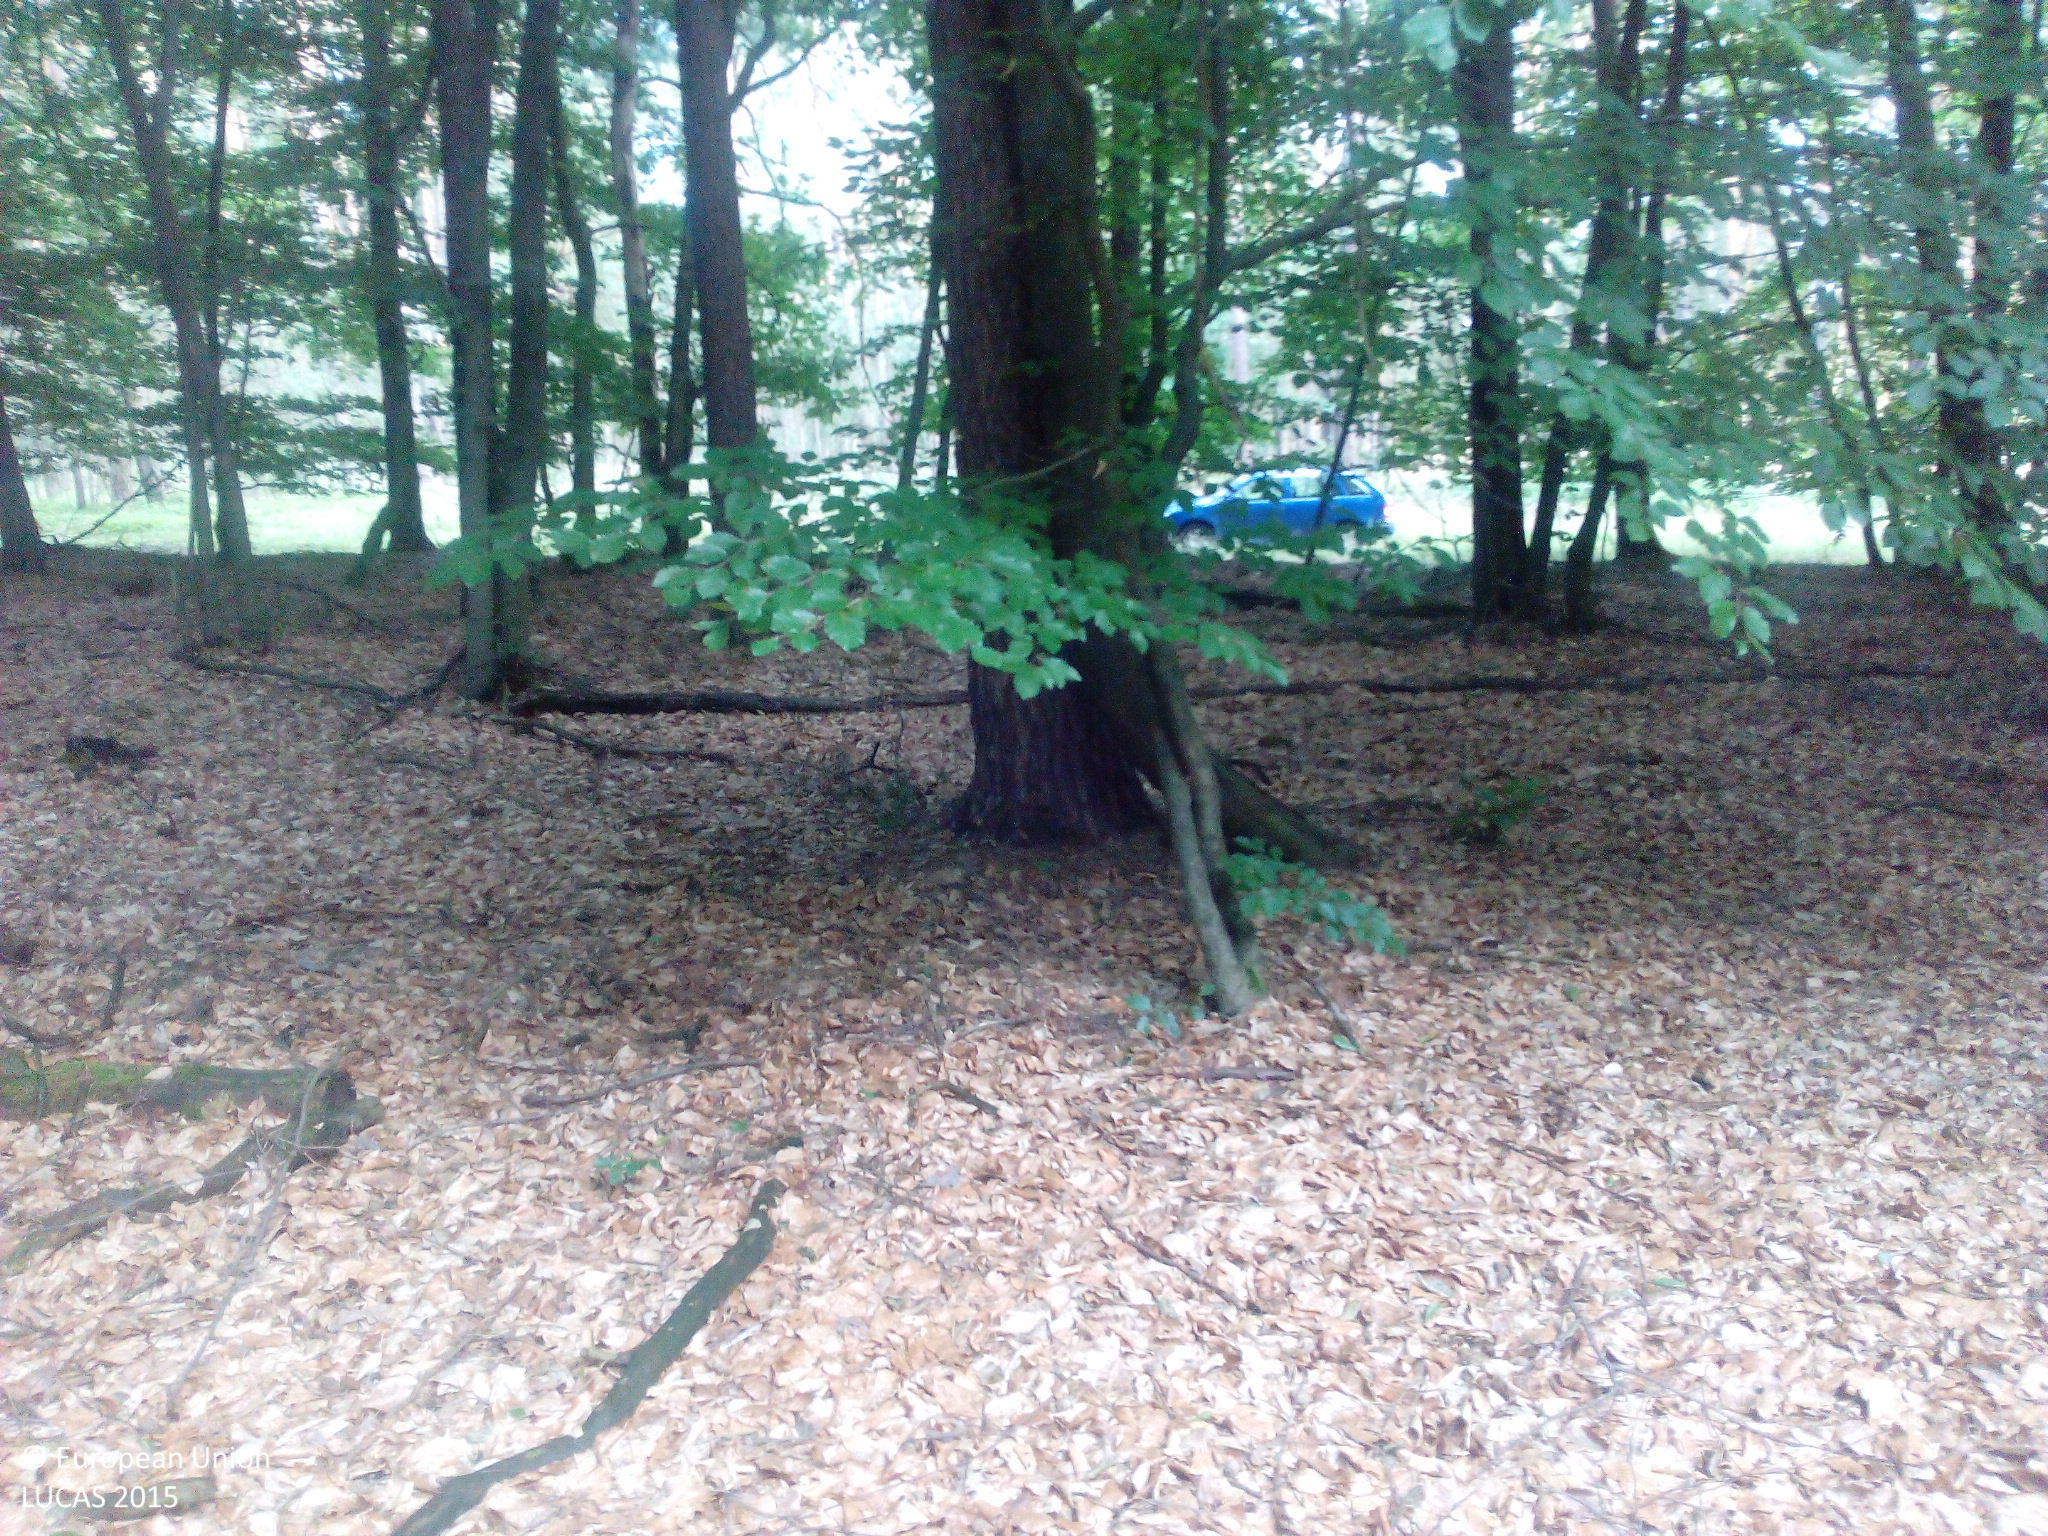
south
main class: Woodland
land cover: Other mixed woodland
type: mesophytic deciduous forest
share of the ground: > 75 %
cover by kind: broadleaved forest trees 70 %, coniferous forest trees 25 %
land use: Forestry
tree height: > 5 m
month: July
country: DE
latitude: 51.9929
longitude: 12.4318
